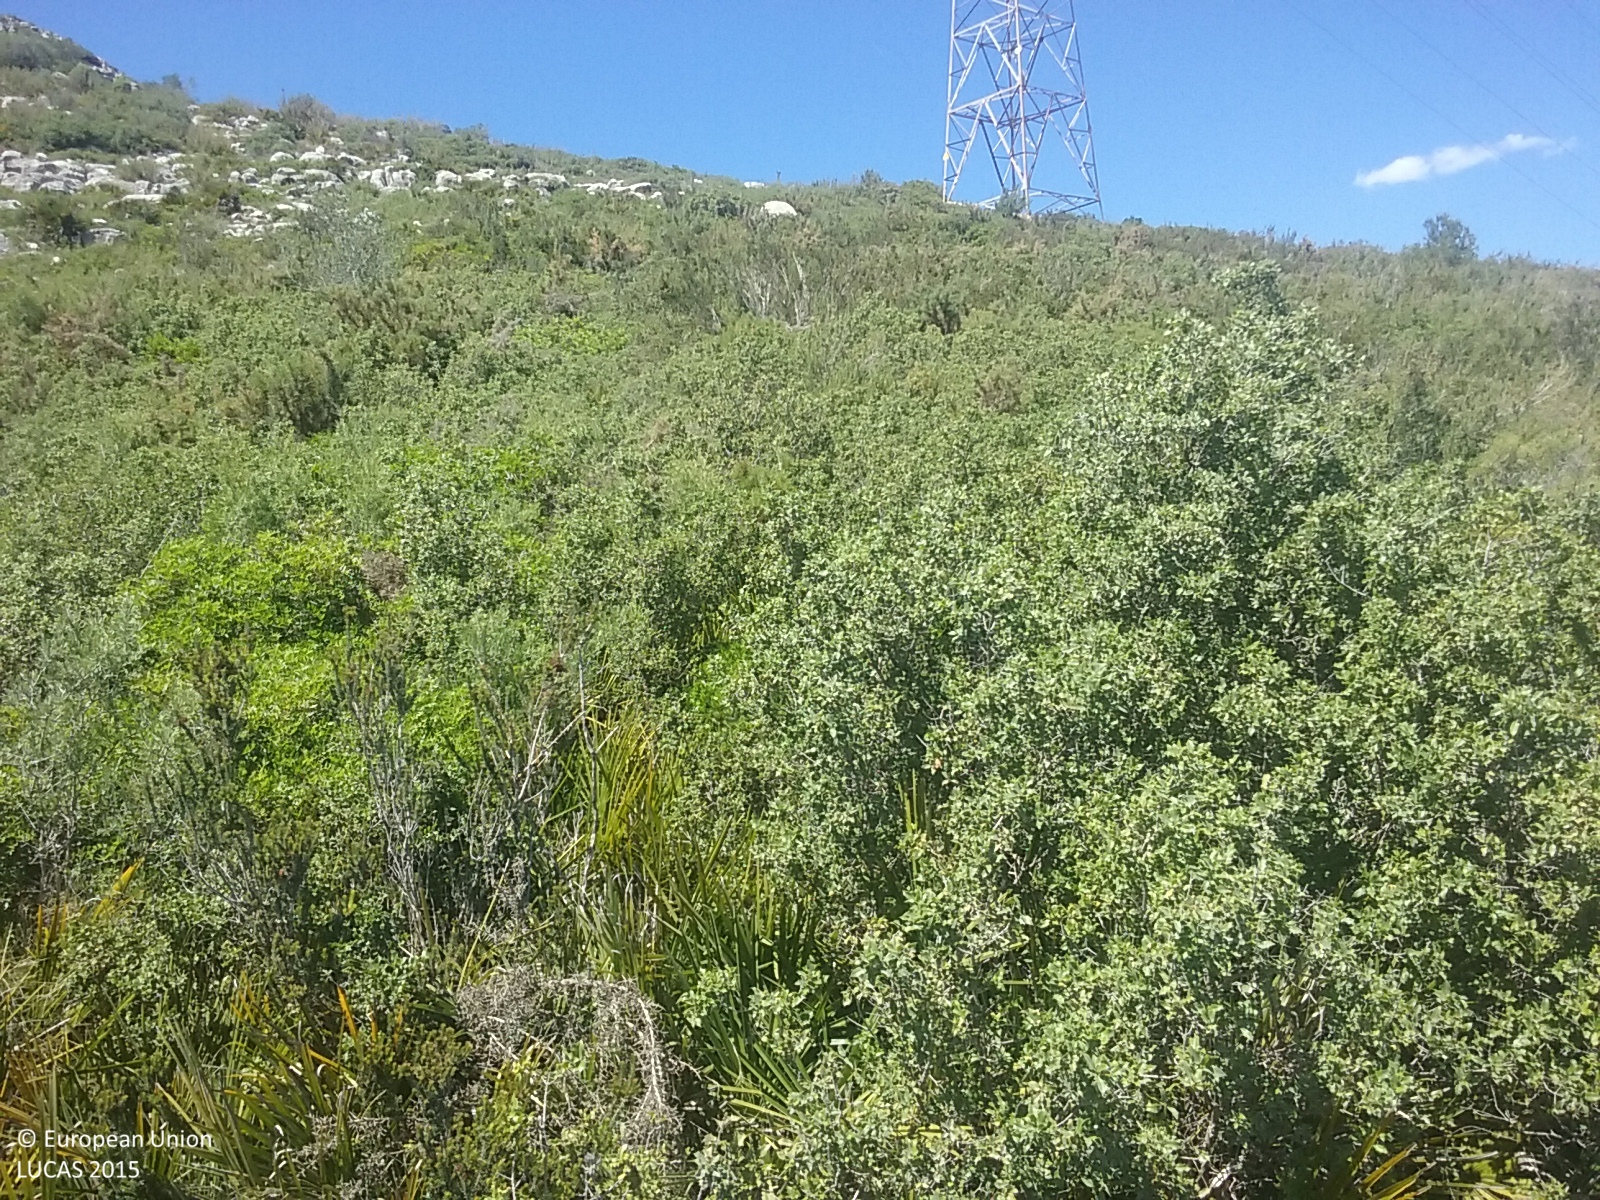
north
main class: Shrubland
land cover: Shrubland with sparse tree cover
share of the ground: > 75 %
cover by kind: shrubs 90 %, broadleaved forest trees 5 %
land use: Semi-natural and natural areas not in use
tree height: < 5 m
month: May
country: ES
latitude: 40.3890
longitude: 0.3251
